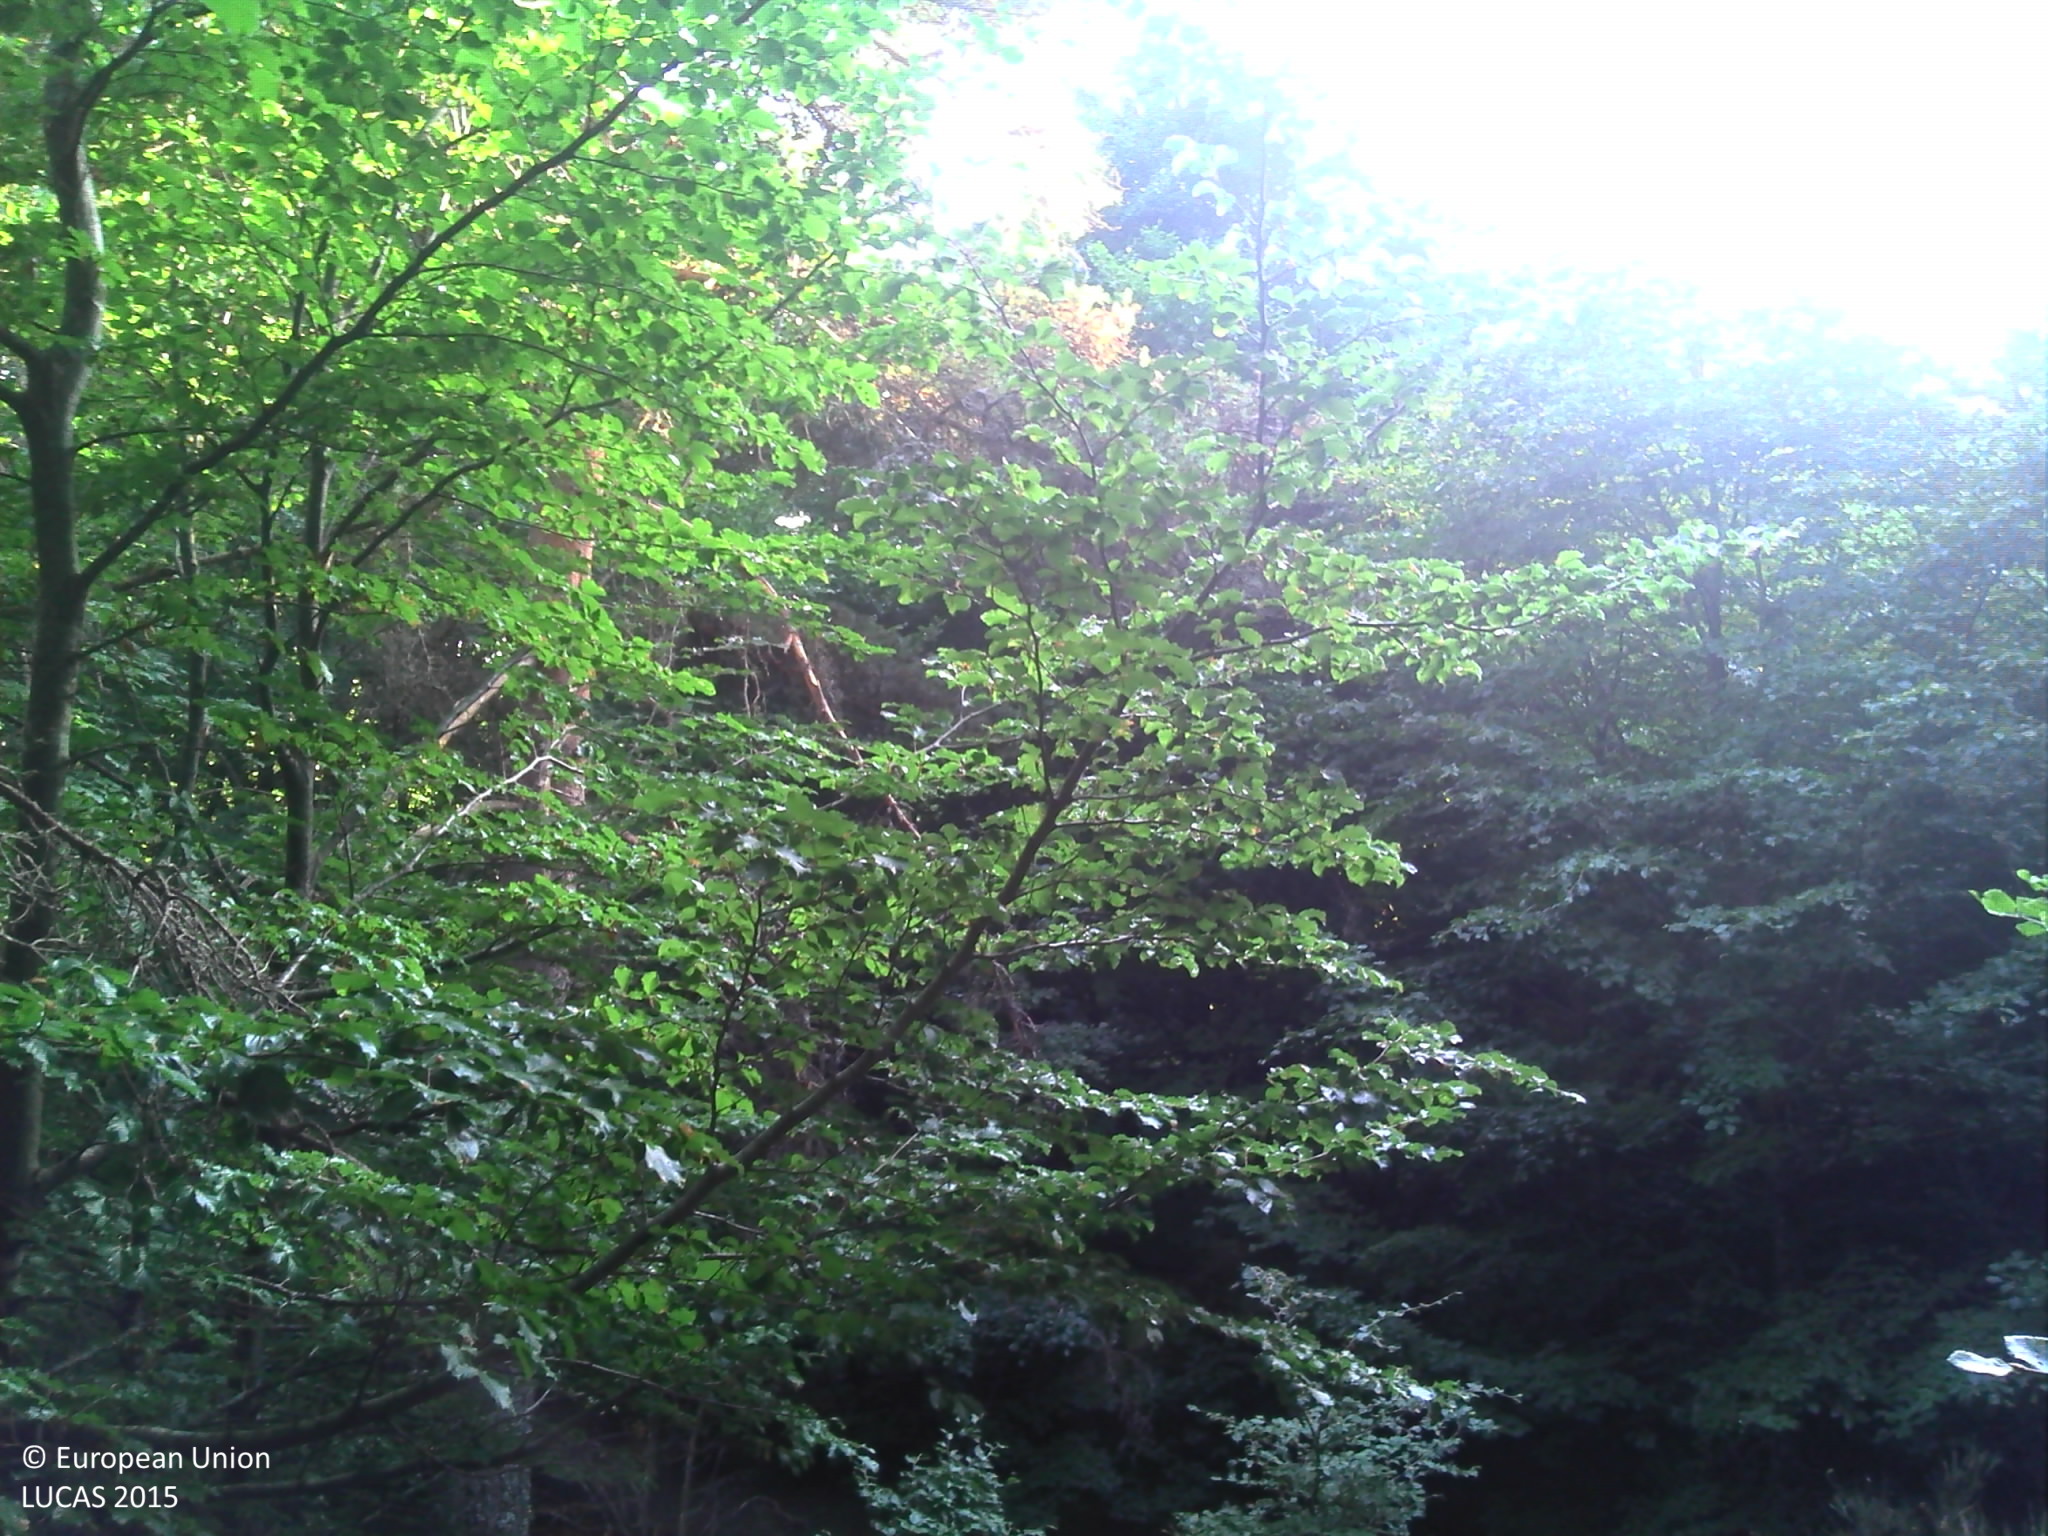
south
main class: Woodland
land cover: Pine dominated mixed woodland
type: beech forest
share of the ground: > 75 %
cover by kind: broadleaved forest trees 65 %, coniferous forest trees 25 %, herbaceous plants 10 %
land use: Forestry
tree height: > 5 m
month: July
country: FR
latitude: 44.1283
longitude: 3.4953
